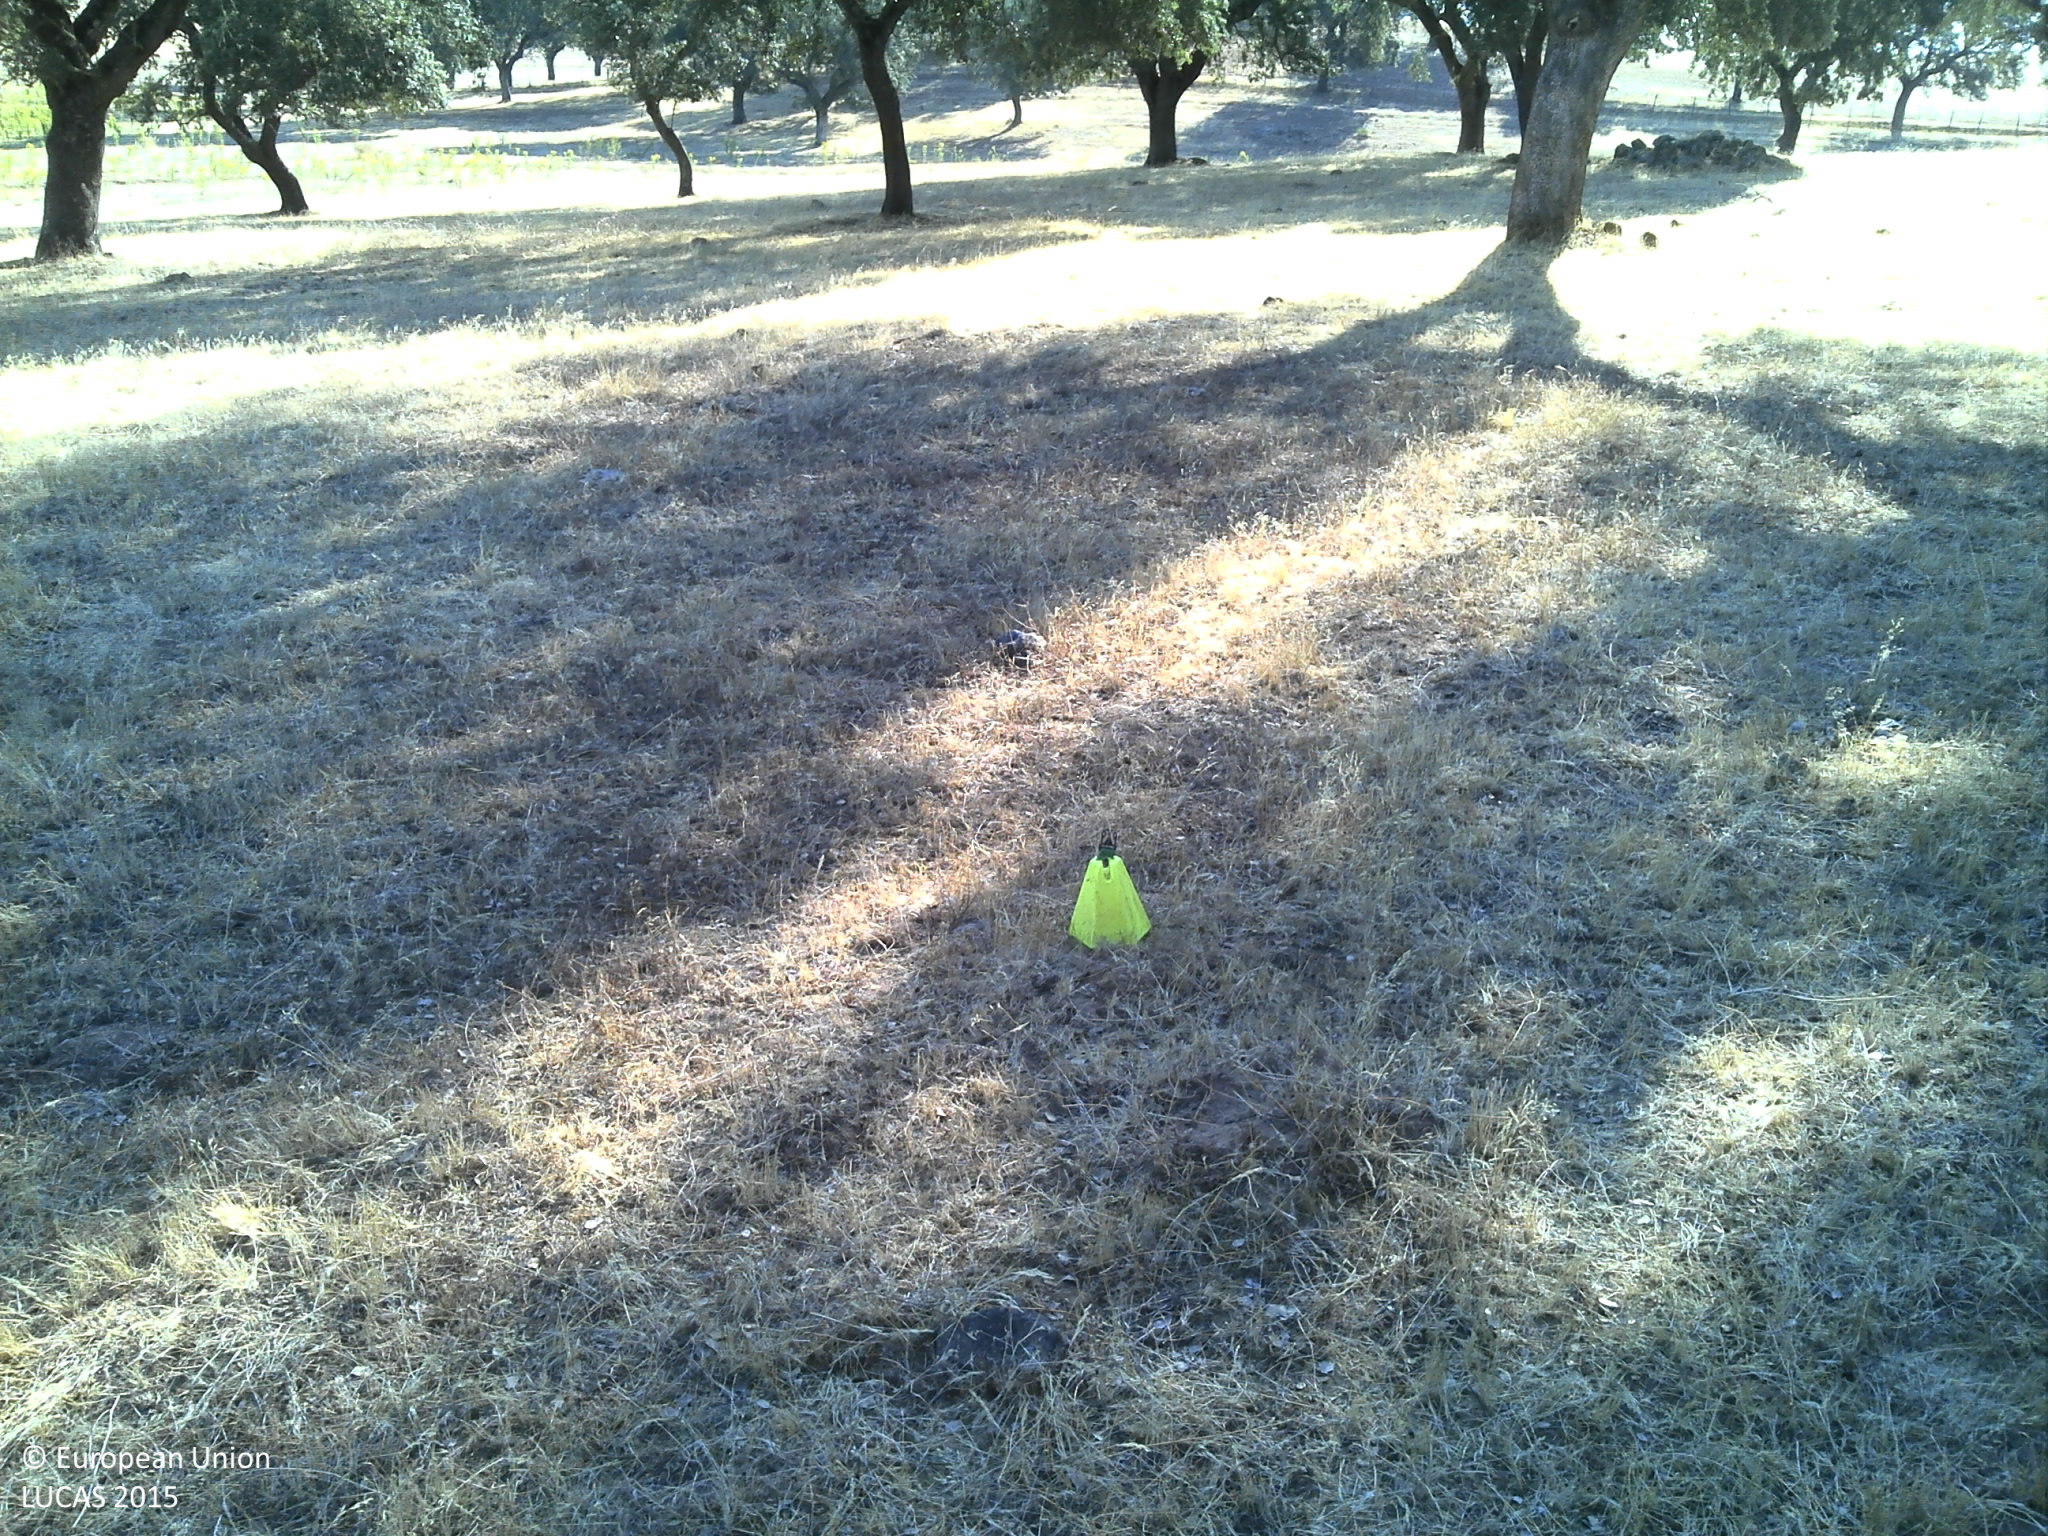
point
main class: Woodland
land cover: Broadleaved woodland
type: broadleaved evergreen forest
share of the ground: 25 - 50 %
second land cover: Grassland without tree/shrub cover
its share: 25 - 50 %
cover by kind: unconsolidated bare surface 50 %, broadleaved forest trees 25 %, herbaceous plants 25 %
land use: Forestry
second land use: Agriculture (excluding fallow land and kitchen gardens)
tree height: > 5 m
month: July
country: PT
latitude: 39.0316
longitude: -7.3984
